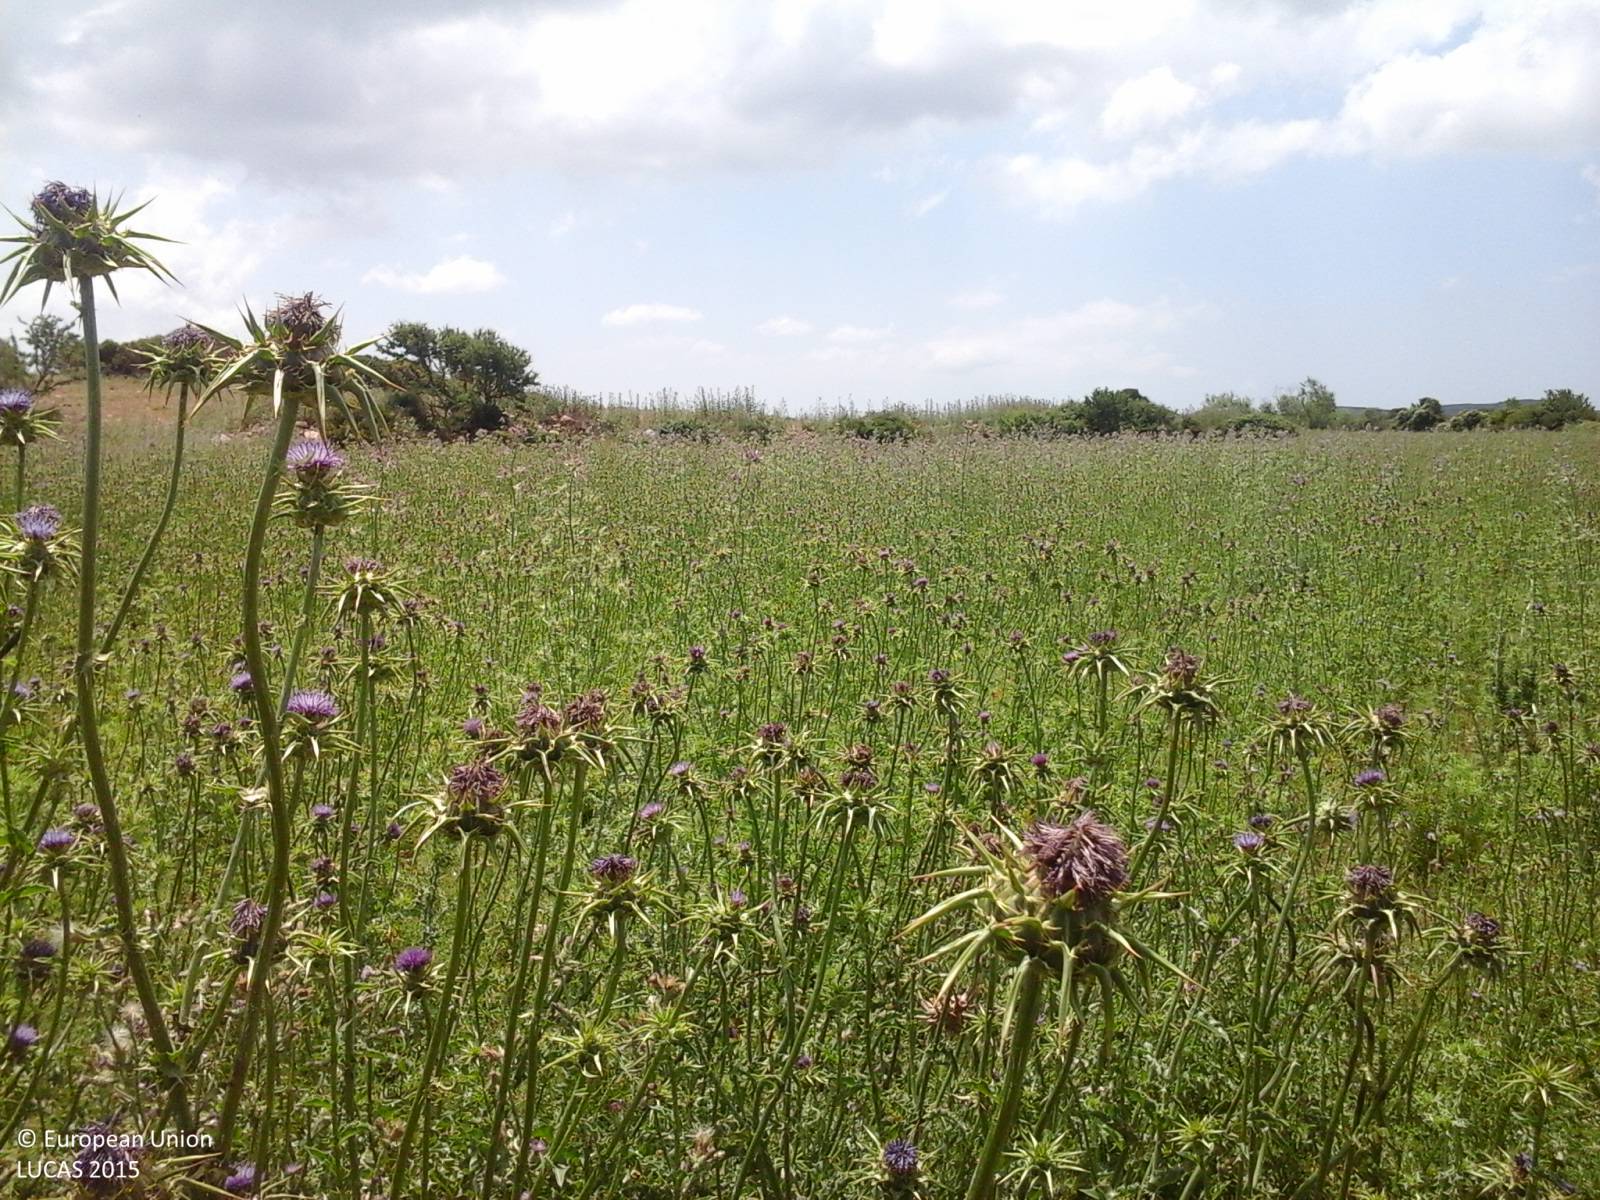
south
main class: Grassland
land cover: Spontaneously vegetated surfaces
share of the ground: > 75 %
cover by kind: herbaceous plants 50 %, shrubs 5 %, unconsolidated bare surface 5 %
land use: Agriculture (excluding fallow land and kitchen gardens)
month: May
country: IT
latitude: 40.7428
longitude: 8.3853
